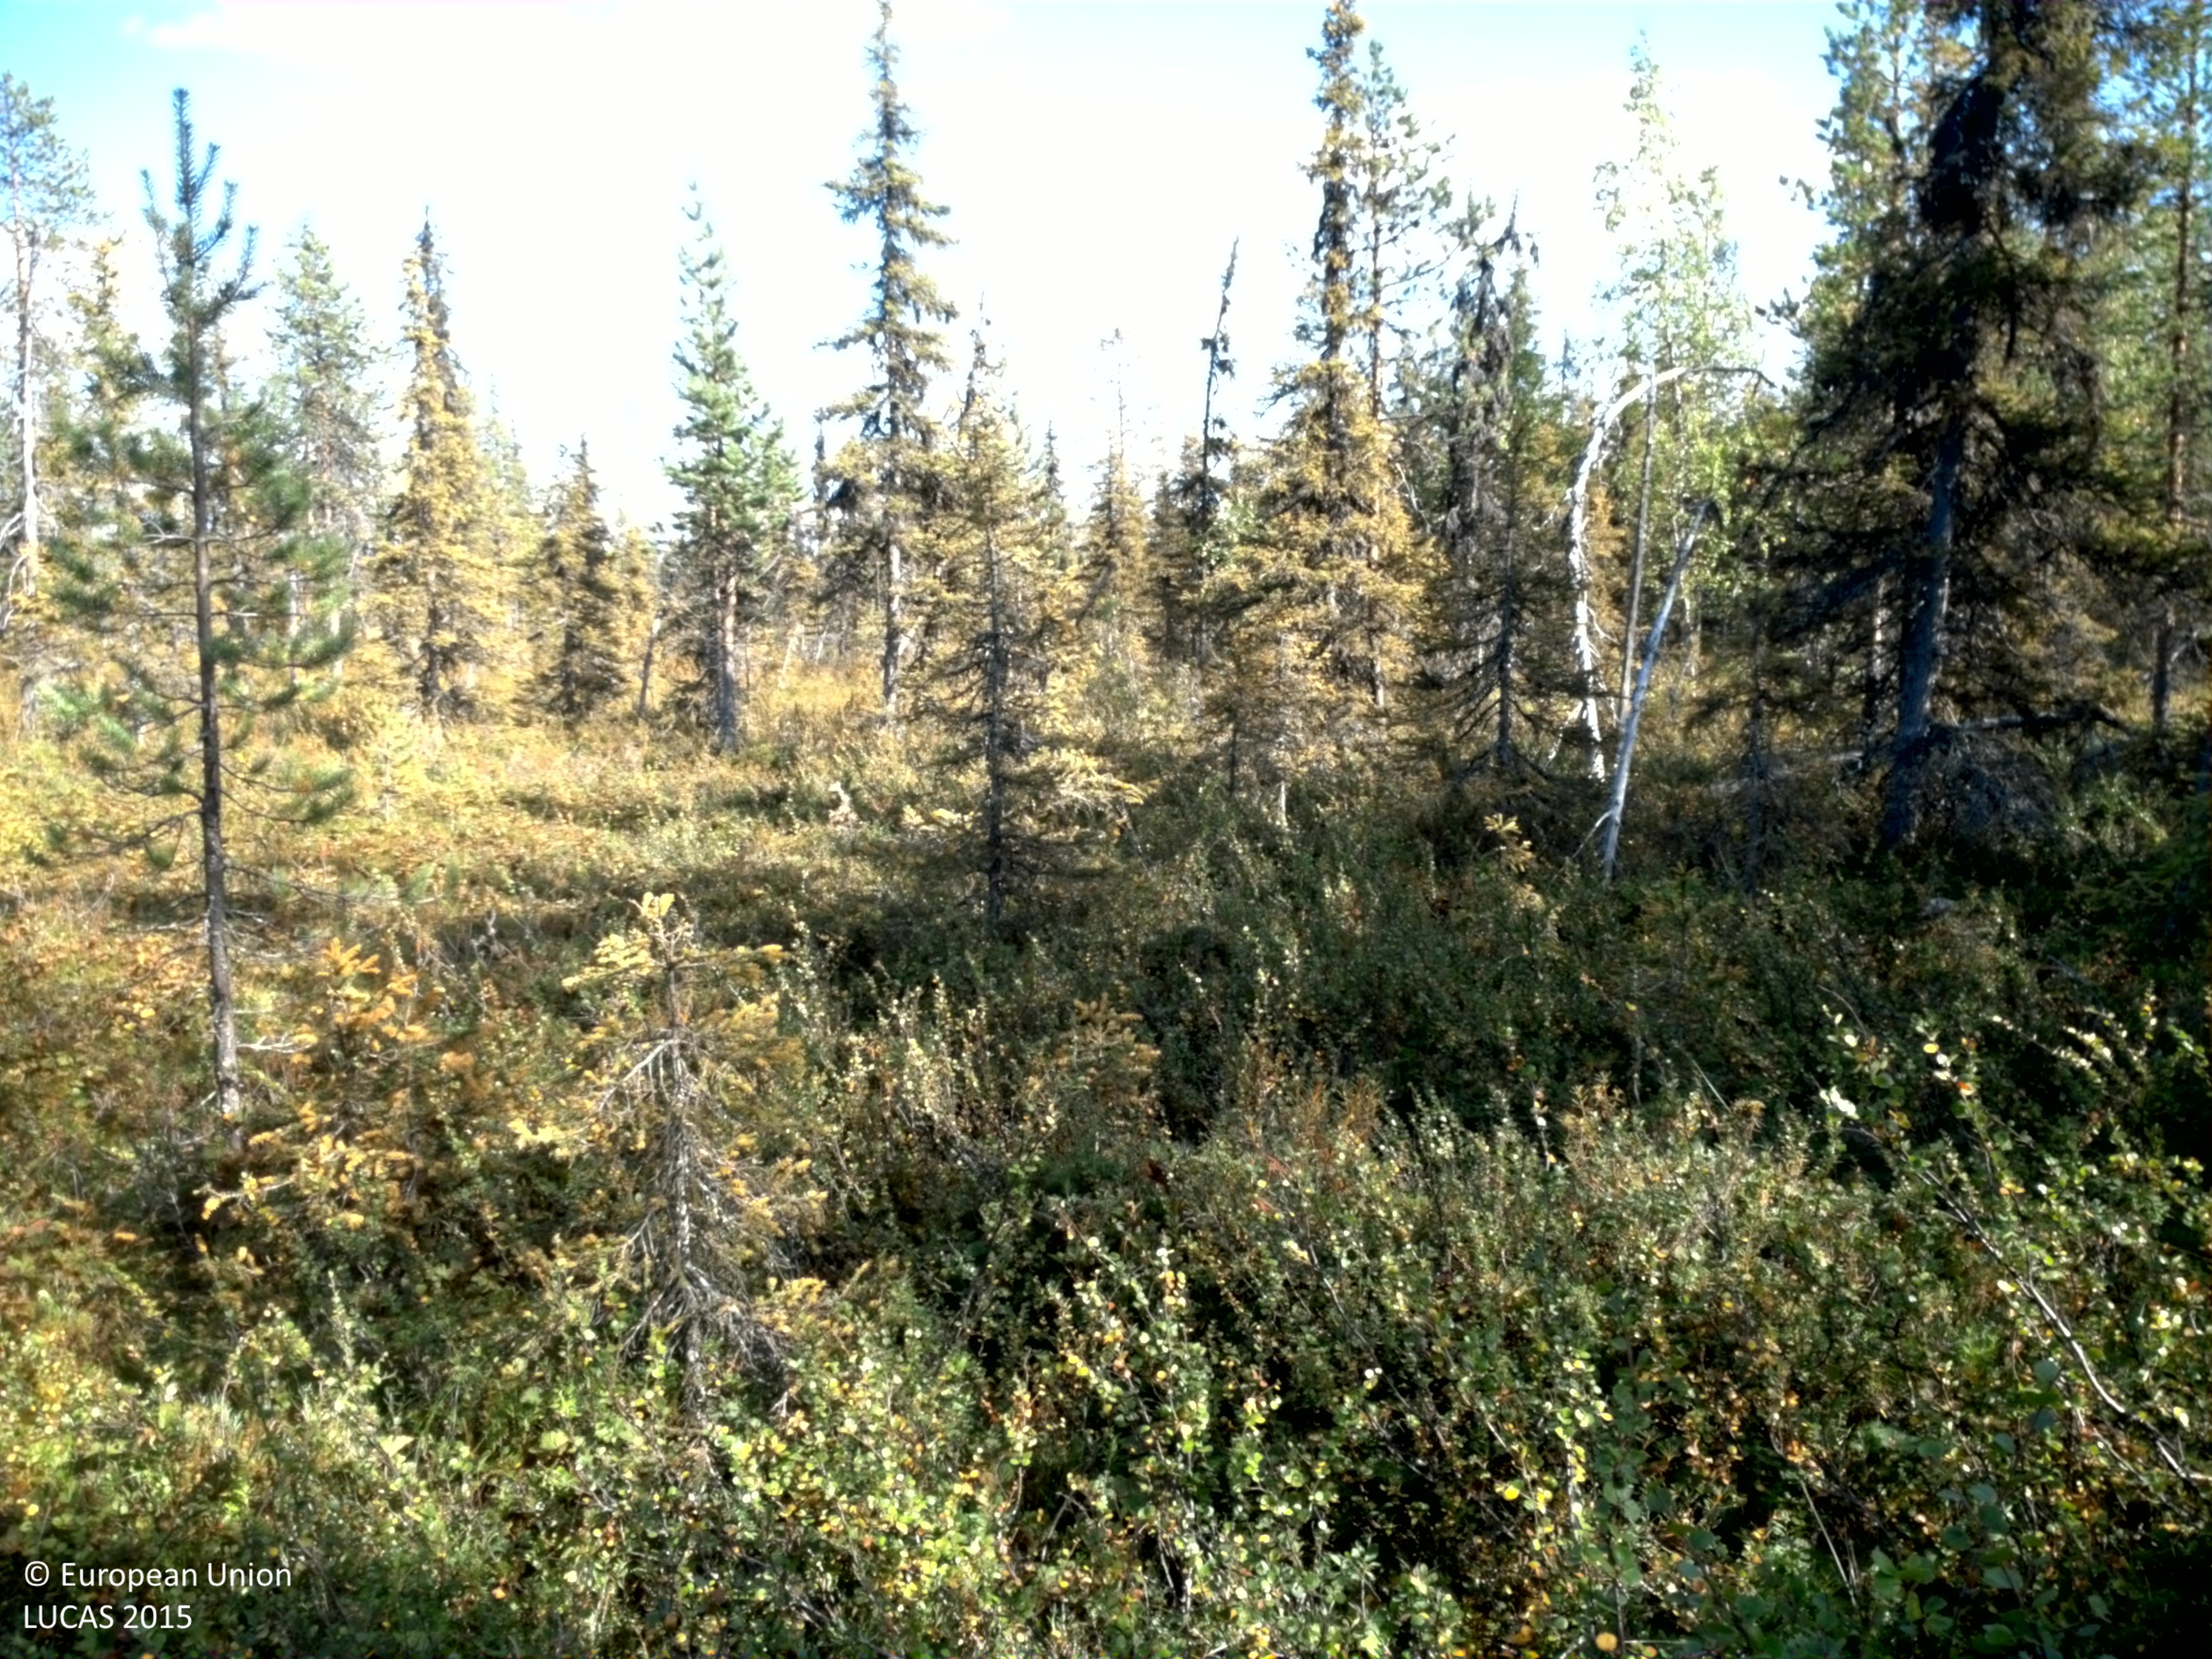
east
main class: Woodland
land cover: Spruce dominated coniferous woodland
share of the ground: 25 - 50 %
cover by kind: shrubs 75 %, coniferous forest trees 25 %
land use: Forestry
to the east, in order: Spruce dominated coniferous woodland; Shrubland with sparse tree cover; Spruce dominated coniferous woodland; Shrubland with sparse tree cover; Peatbogs; Shrubland with sparse tree cover; Pine dominated coniferous woodland; Spruce dominated coniferous woodland
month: August
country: SE
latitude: 66.7690
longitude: 20.8374
